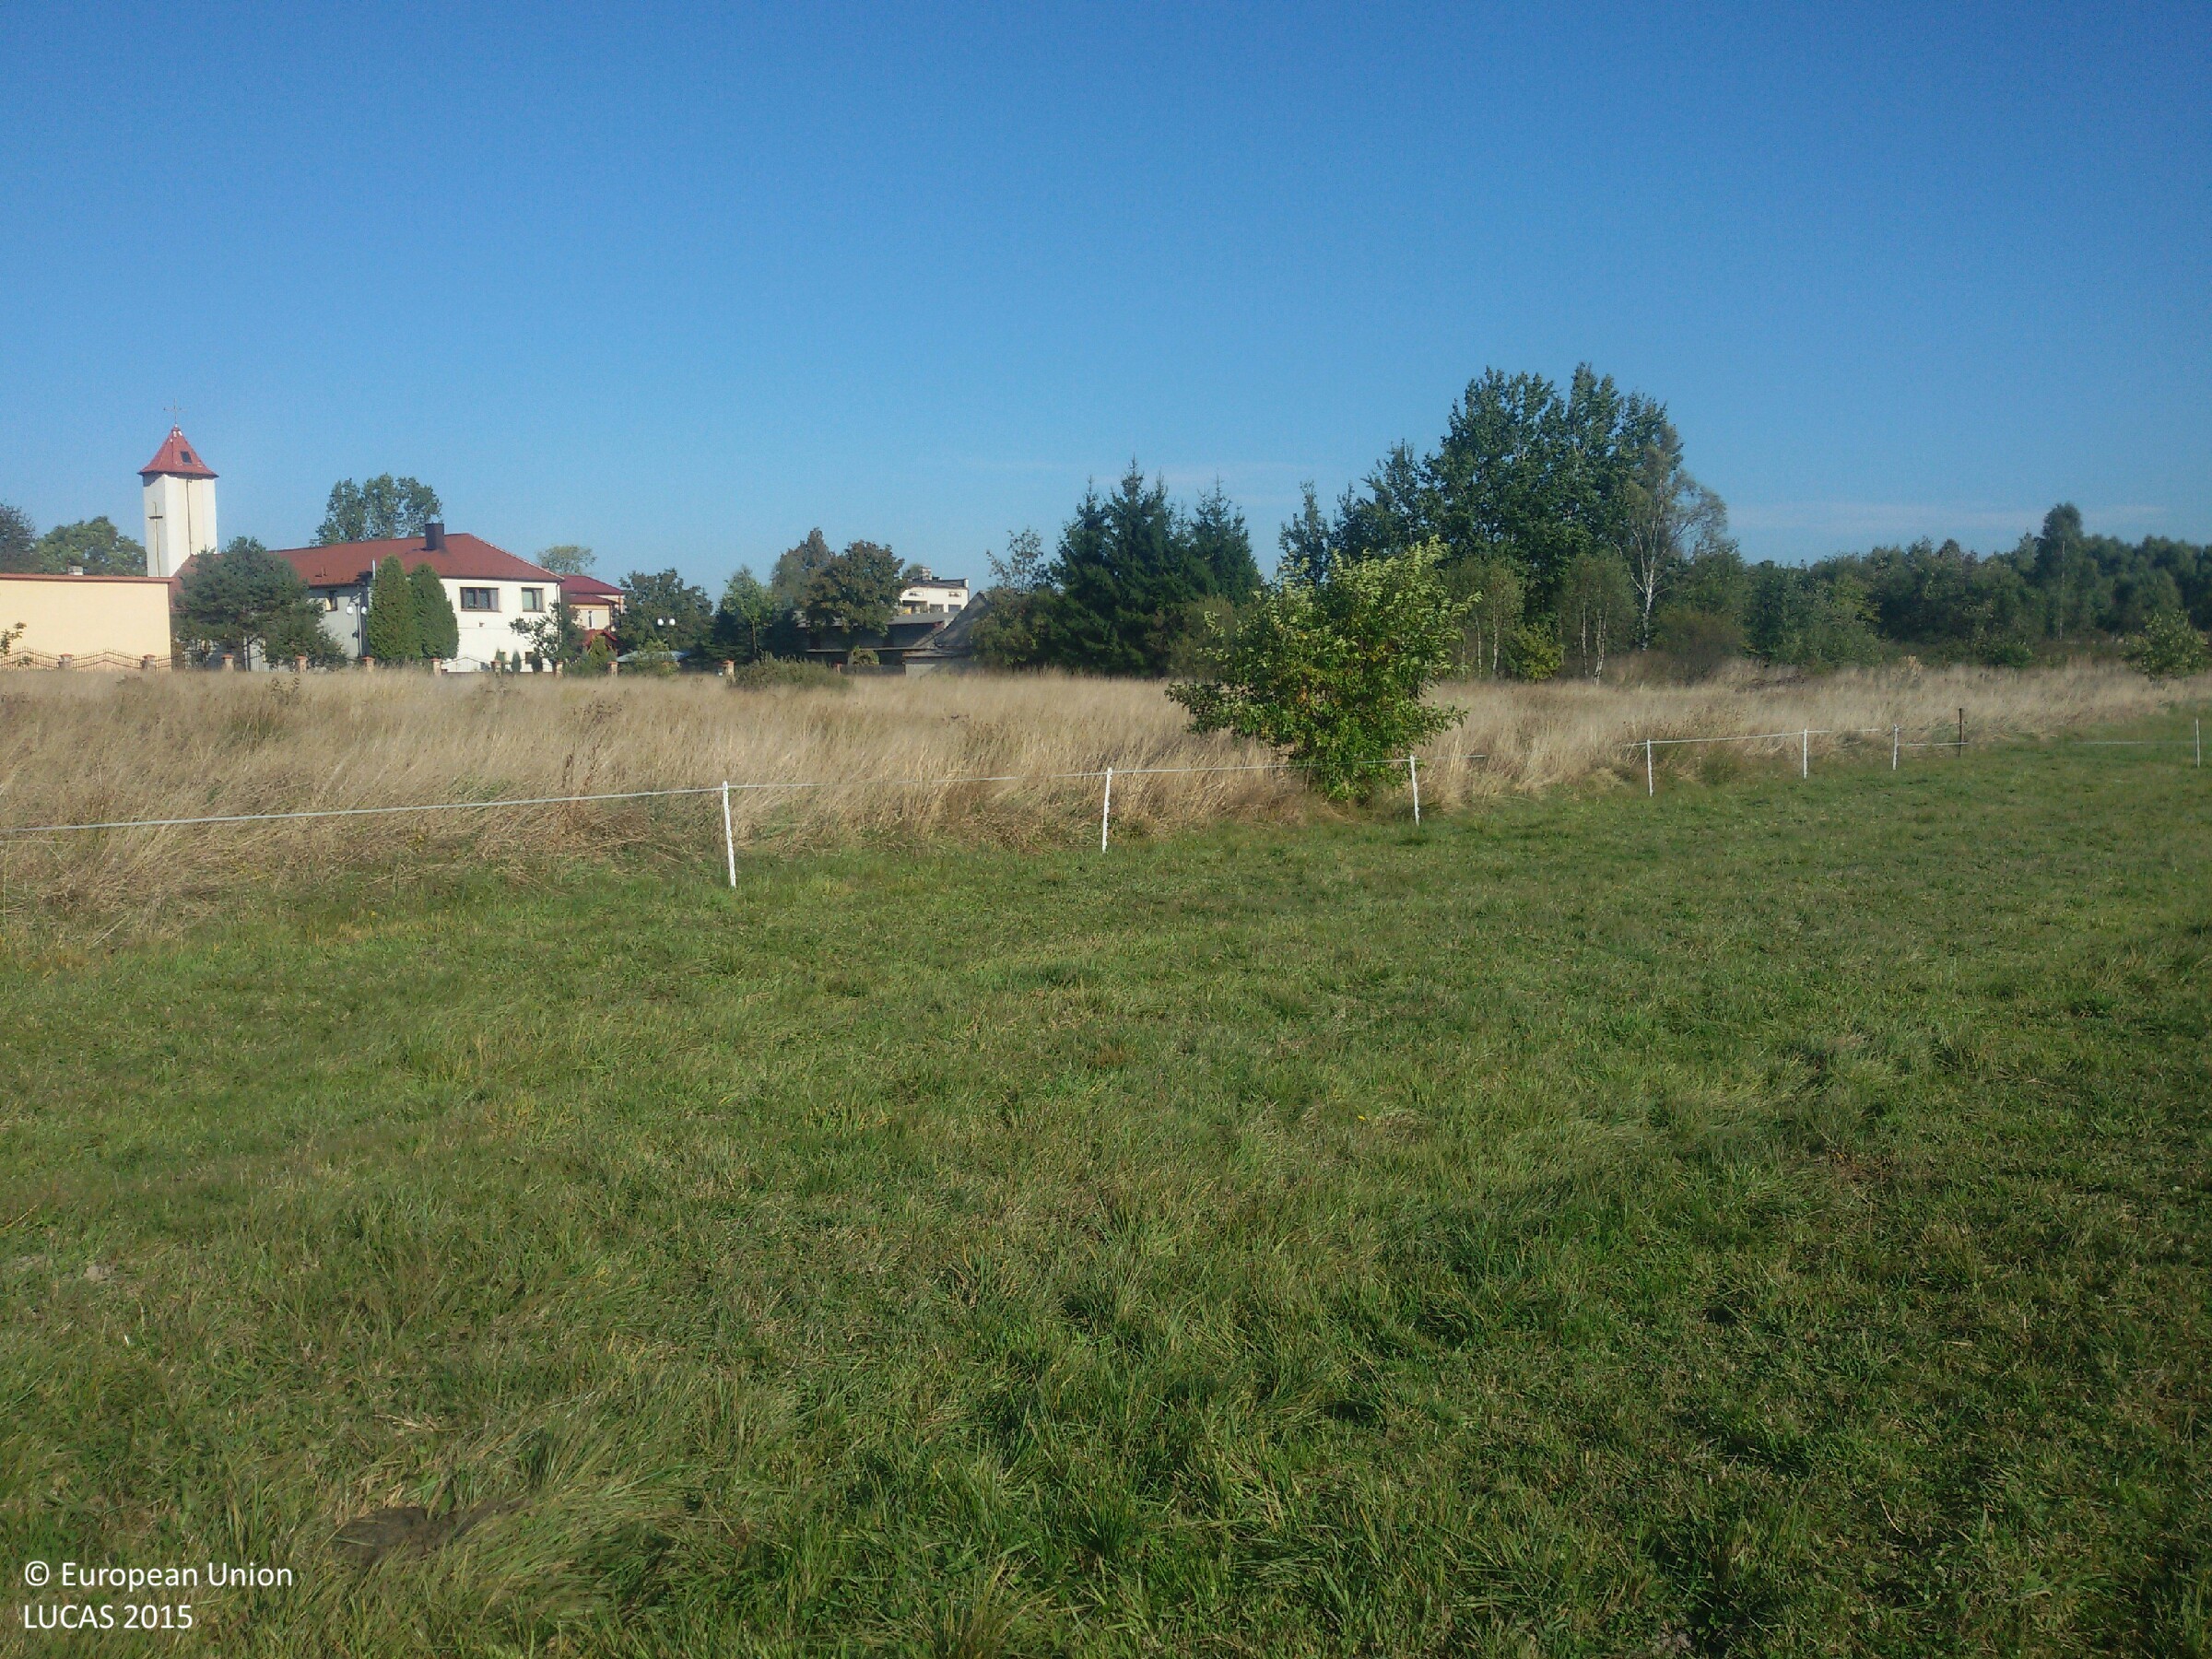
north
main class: Grassland
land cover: Grassland without tree/shrub cover
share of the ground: > 75 %
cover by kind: herbaceous plants 100 %
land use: Agriculture (excluding fallow land and kitchen gardens)
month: September
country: PL
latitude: 51.1487
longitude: 20.8934
